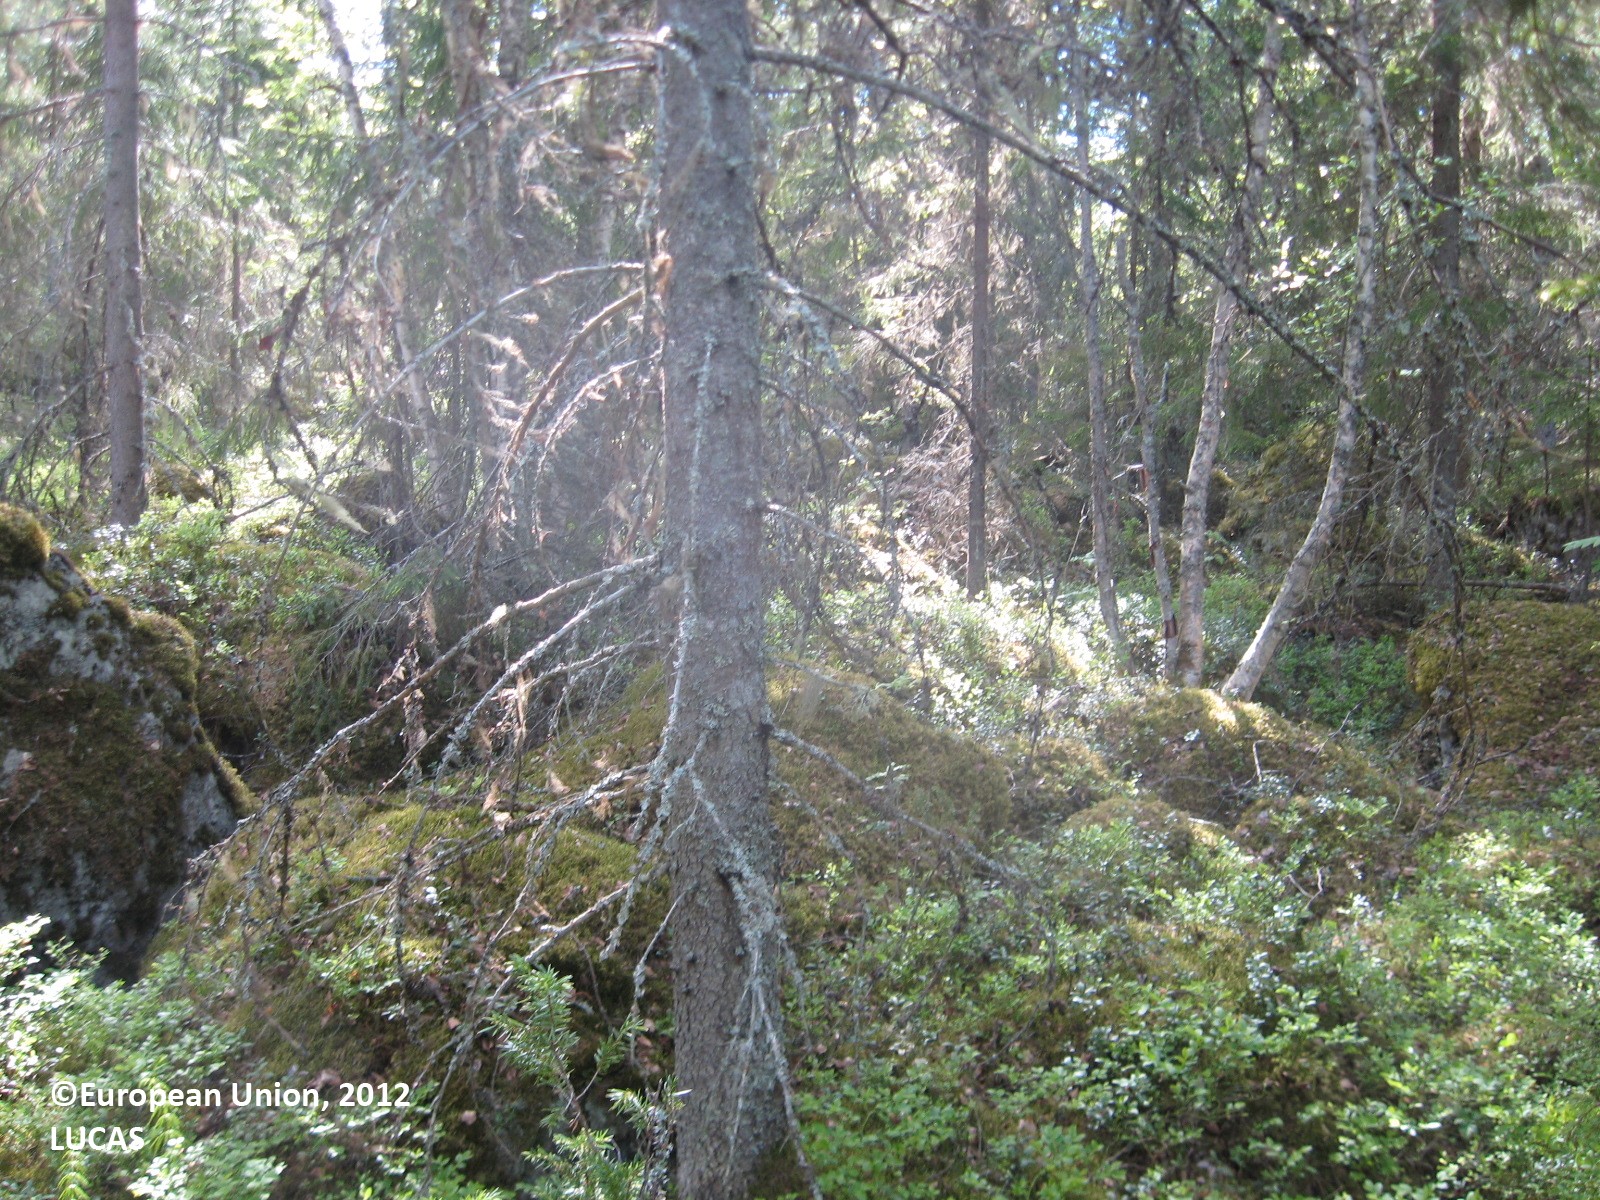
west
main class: Woodland
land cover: Spruce dominated mixed woodland
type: boreal forest
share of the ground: > 75 %
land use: Forestry
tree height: > 5 m
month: June
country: FI
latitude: 63.2157
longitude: 21.9171
